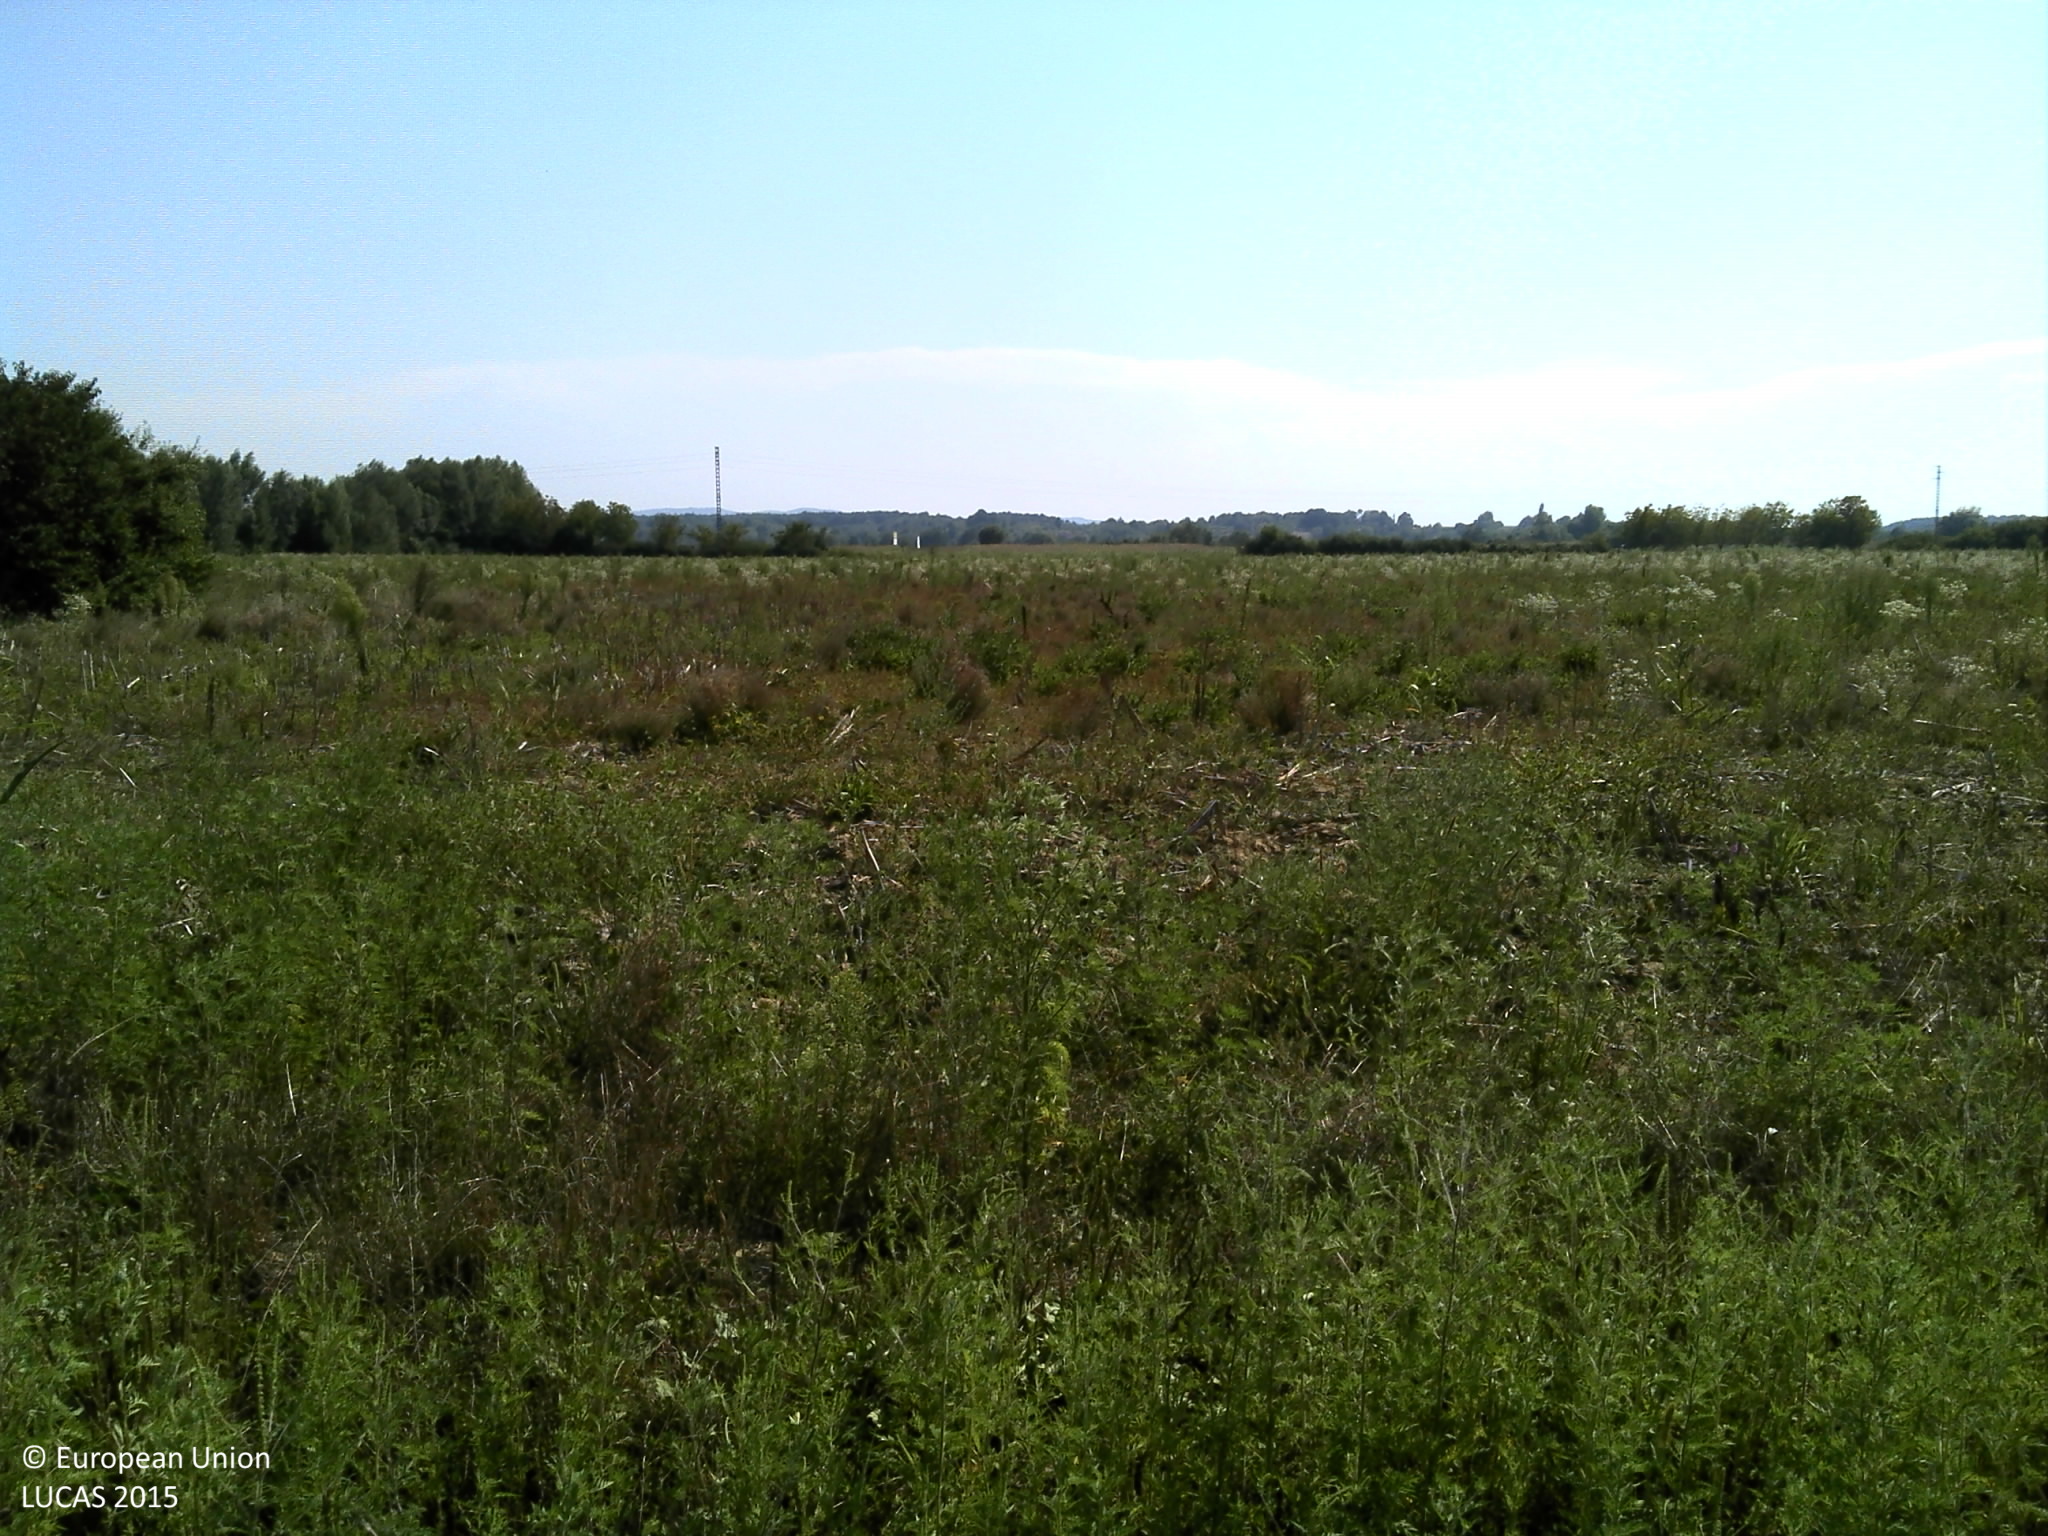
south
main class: Cropland
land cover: Barley
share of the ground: > 75 %
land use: Agriculture (excluding fallow land and kitchen gardens)
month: August
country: HR
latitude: 45.5160
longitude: 16.2831
